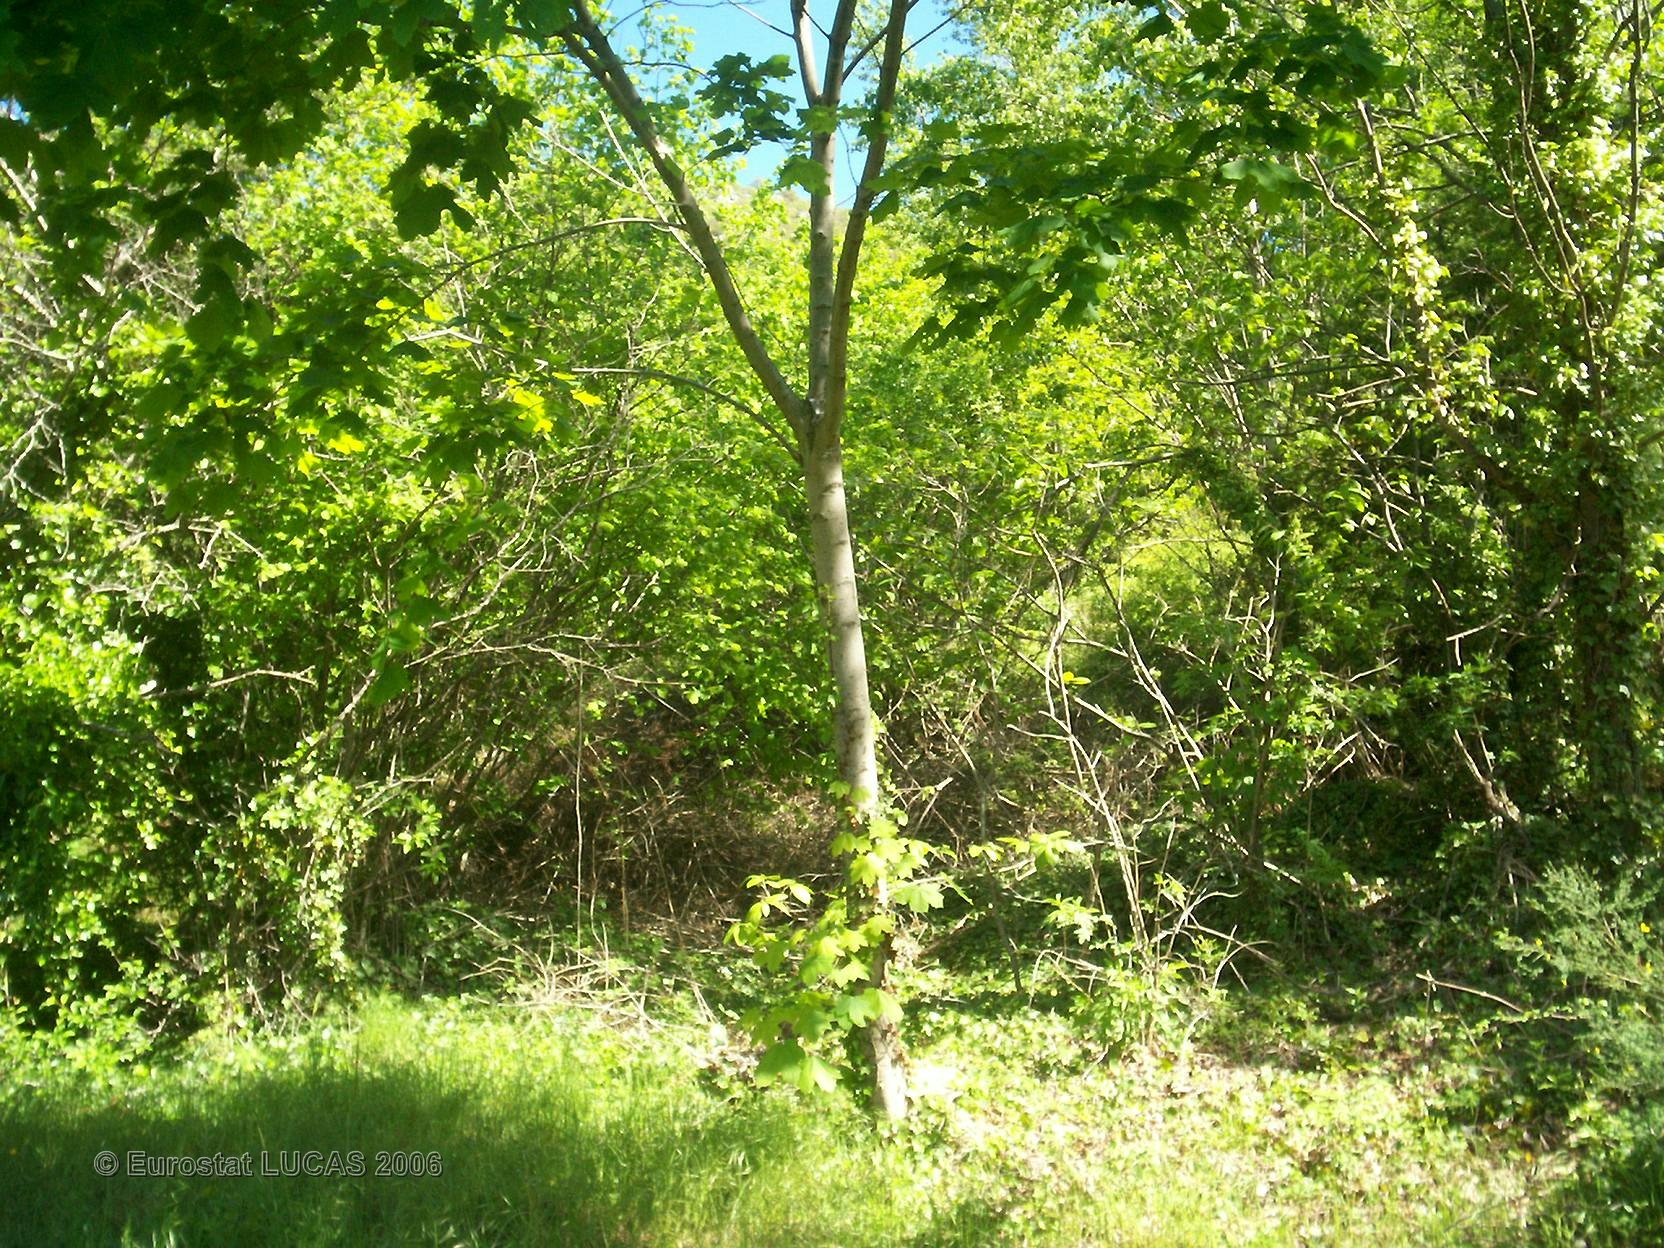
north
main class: Grassland
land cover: Grassland with sparse tree/shrub cover
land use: Residential
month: May
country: FR
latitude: 44.0010
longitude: 3.4848
